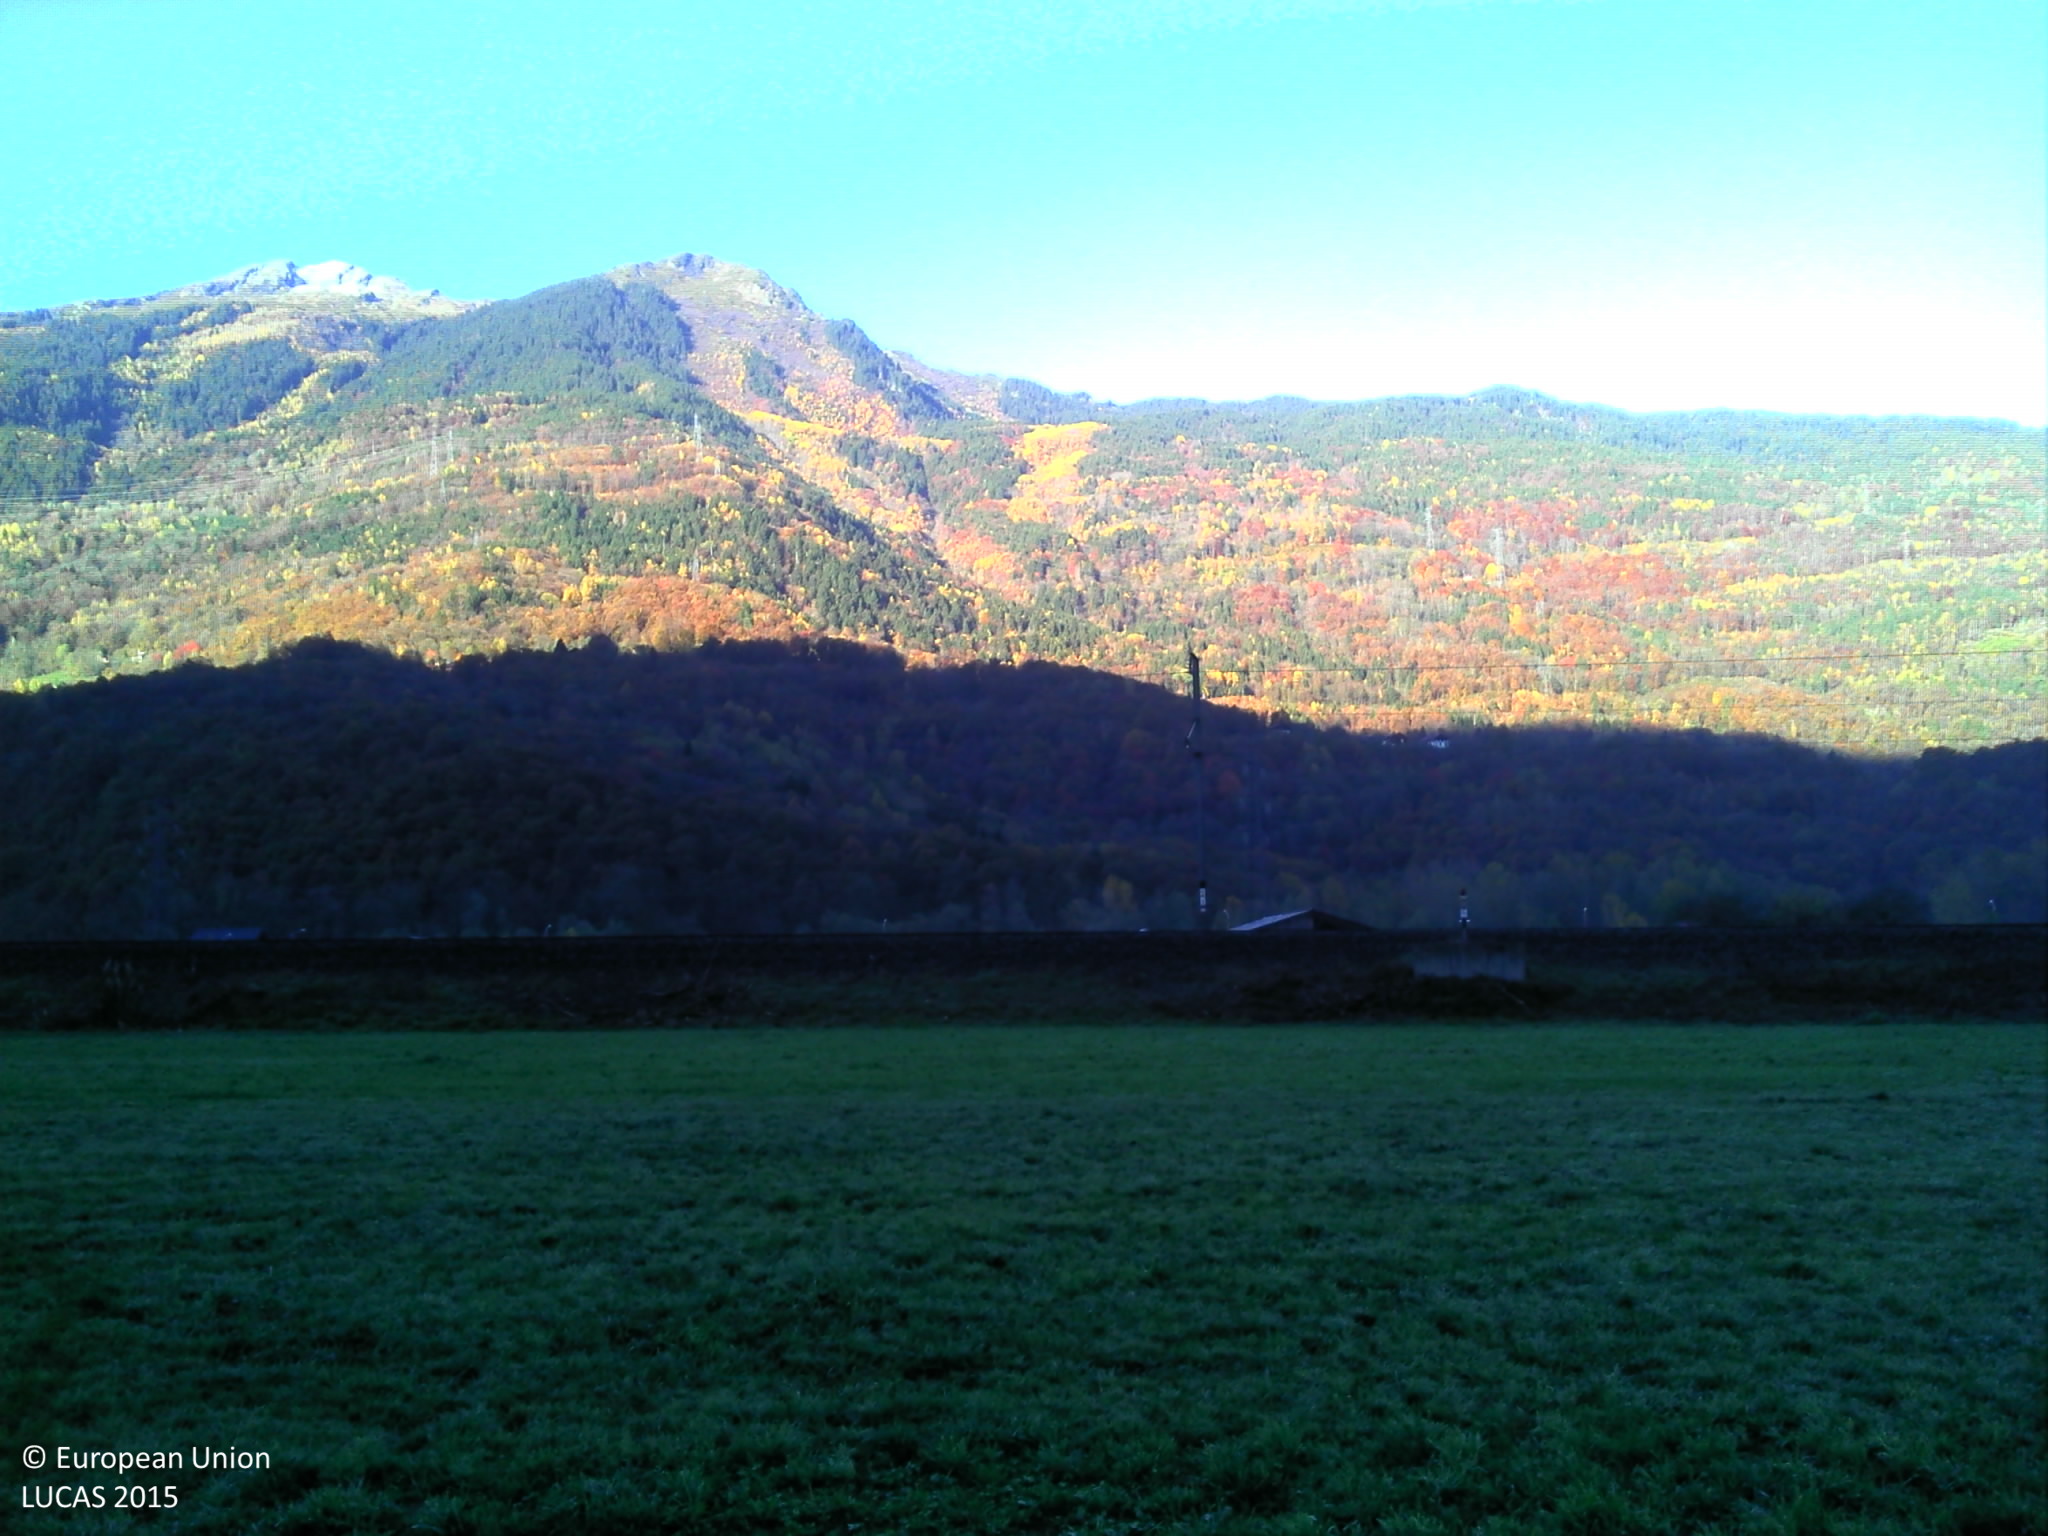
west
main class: Grassland
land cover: Grassland without tree/shrub cover
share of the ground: > 75 %
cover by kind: herbaceous plants 100 %
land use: Agriculture (excluding fallow land and kitchen gardens)
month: October
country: FR
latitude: 45.6072
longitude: 6.4527
